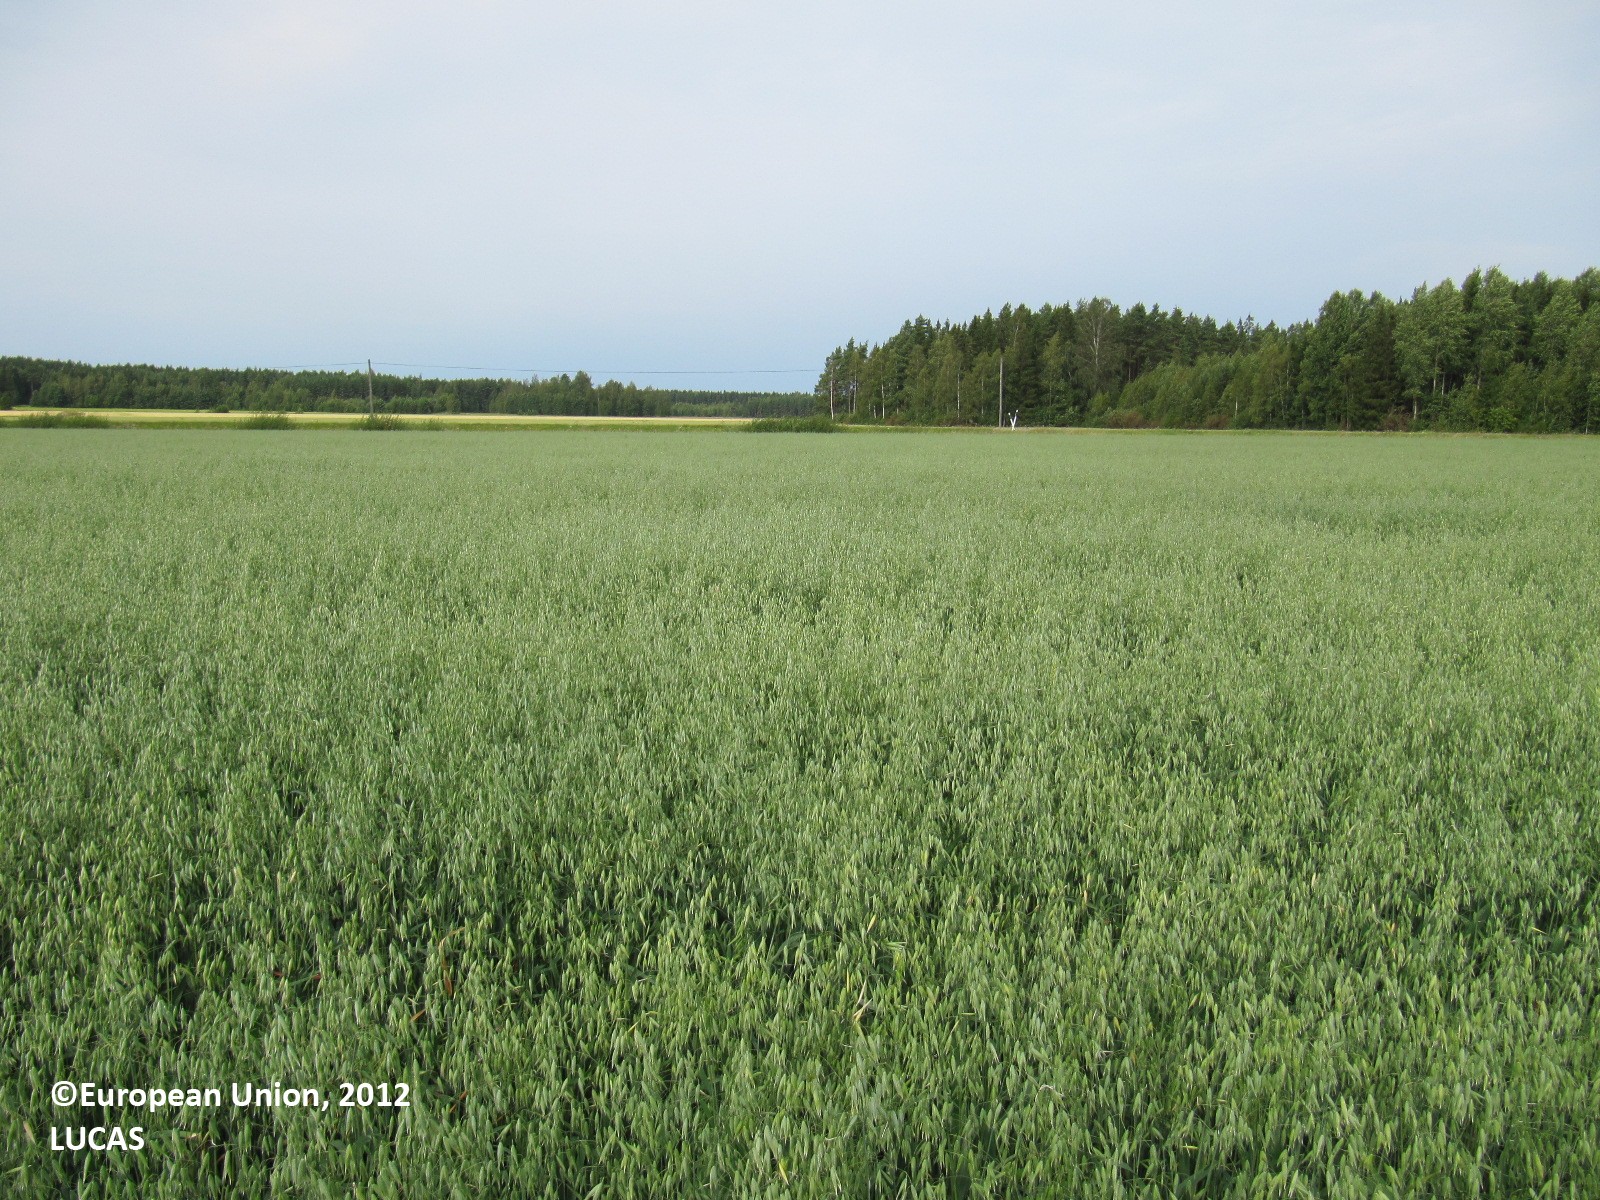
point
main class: Cropland
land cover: Oats
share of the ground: > 75 %
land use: Agriculture (excluding fallow land and kitchen gardens)
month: August
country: FI
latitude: 60.4826
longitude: 23.2748
